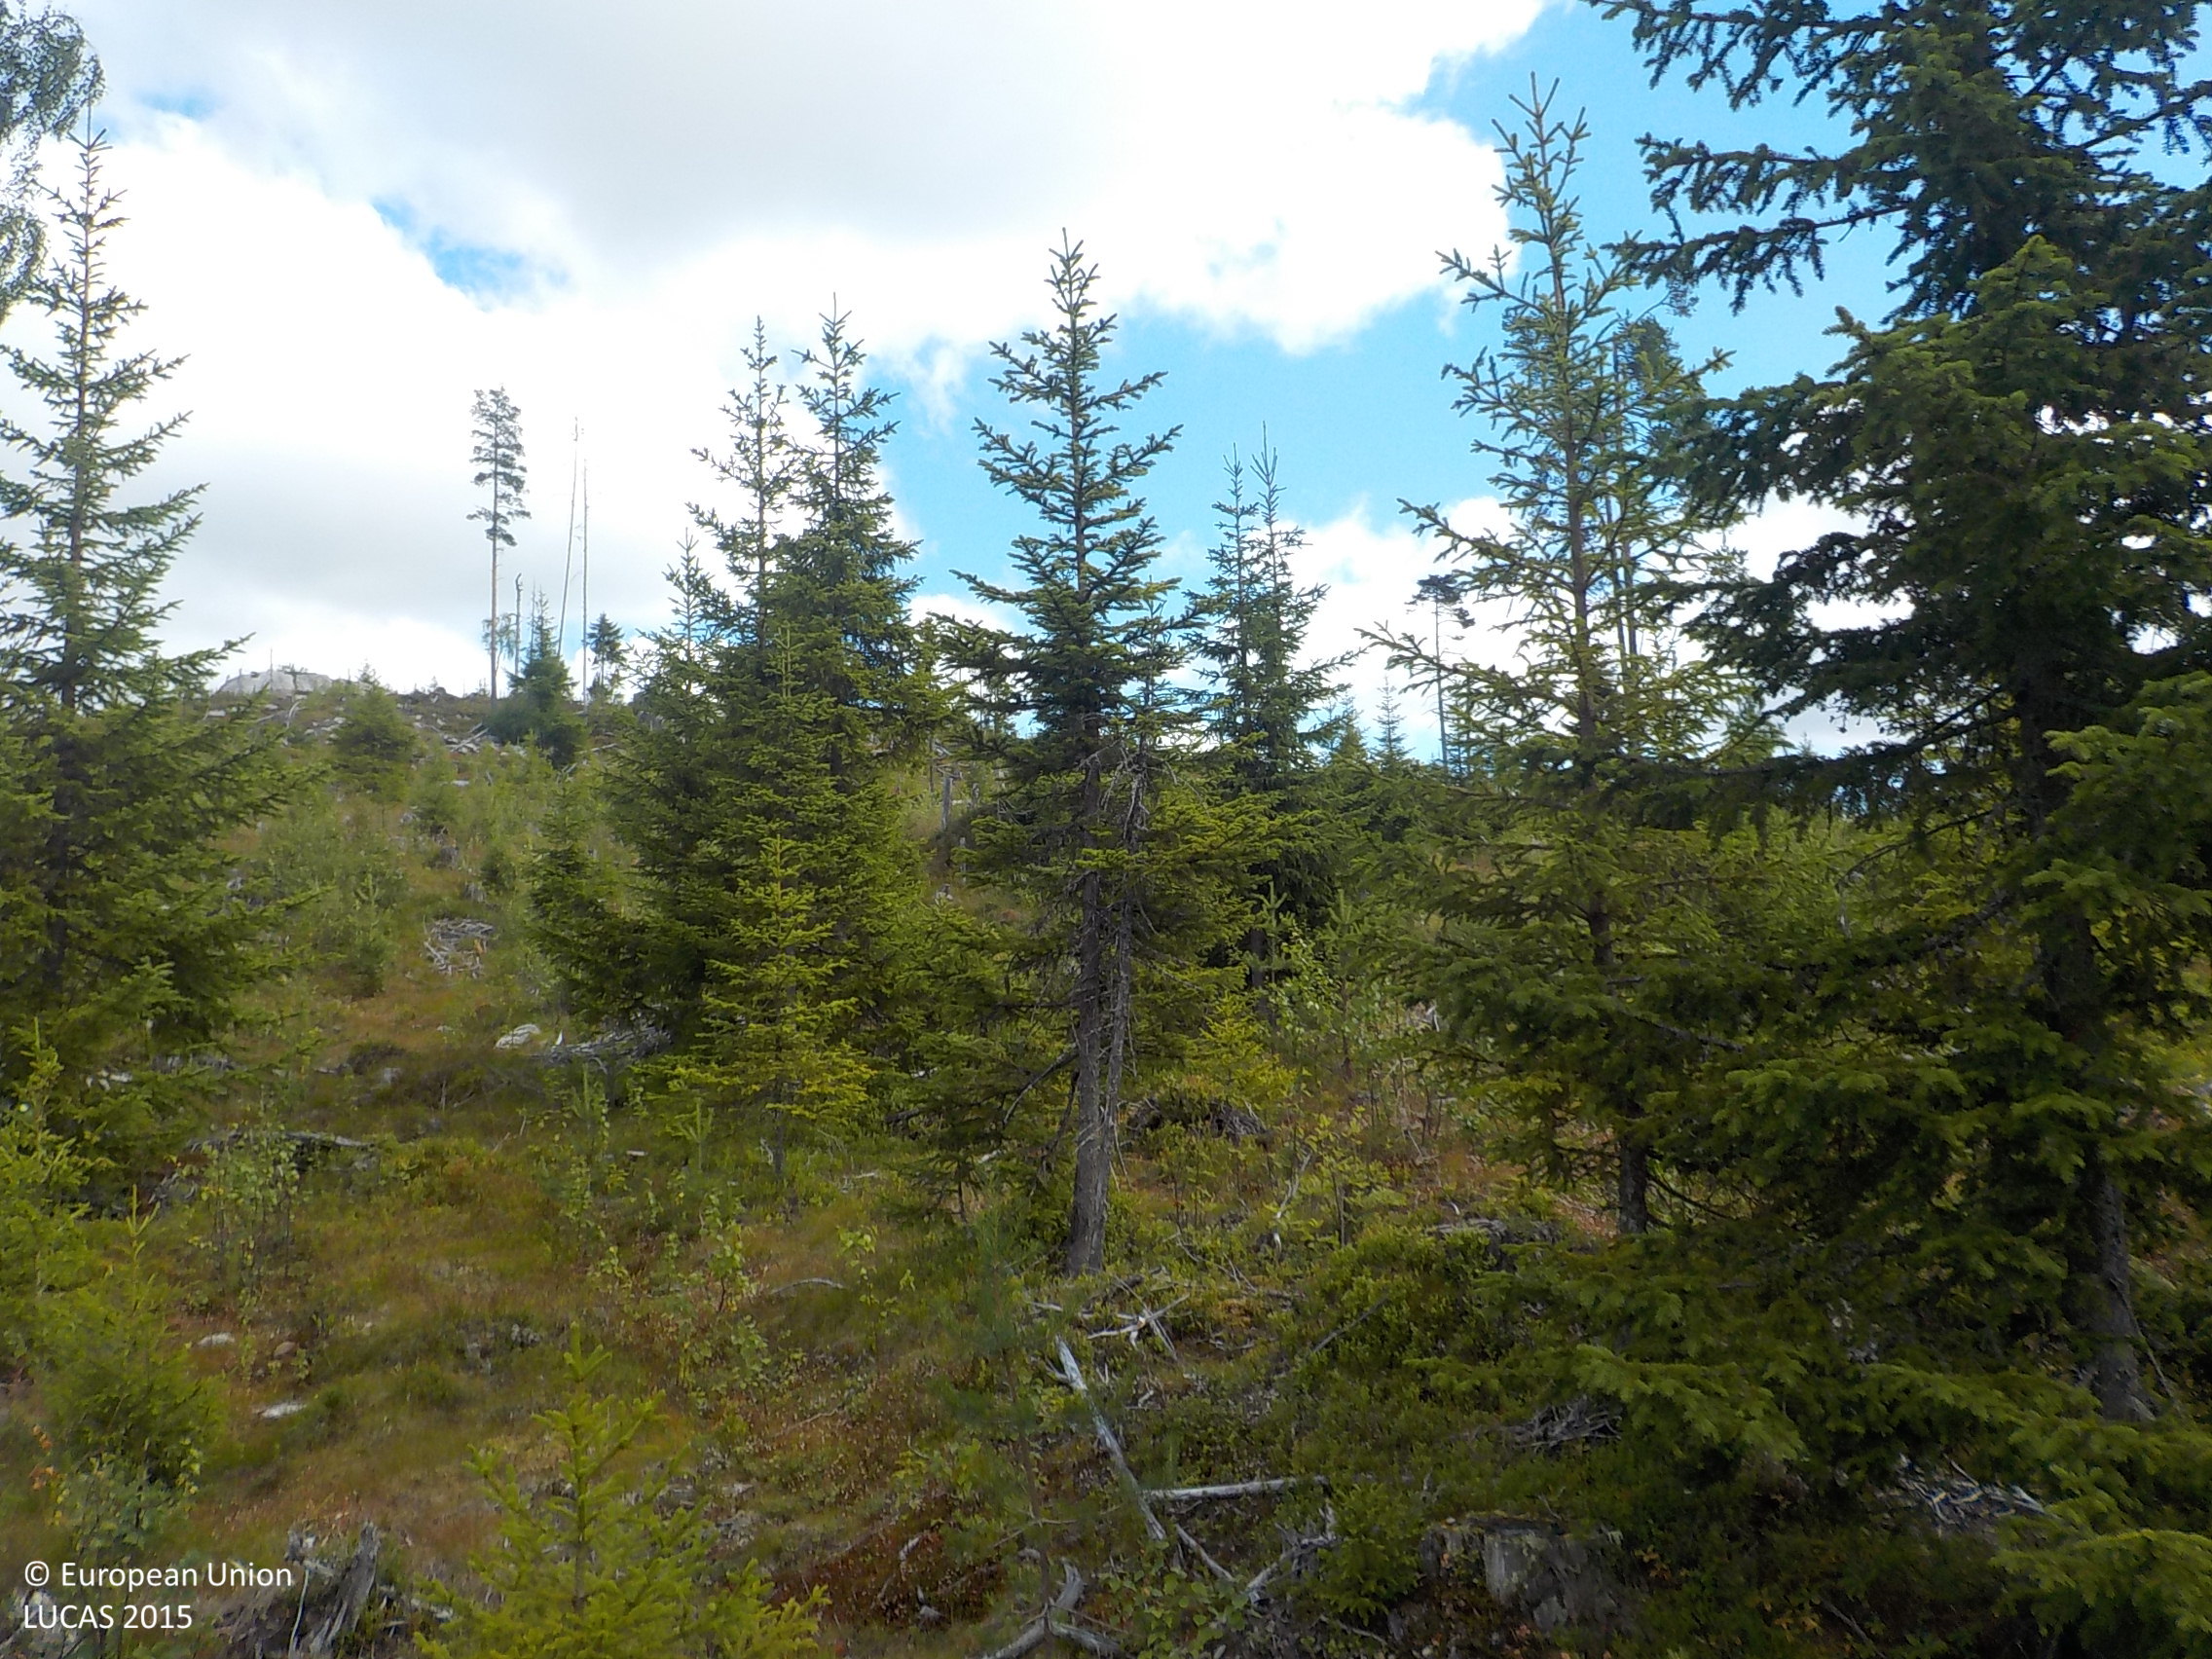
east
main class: Woodland
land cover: Spruce dominated mixed woodland
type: boreal forest
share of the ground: 25 - 50 %
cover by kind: herbaceous plants 60 %, coniferous forest trees 20 %, broadleaved forest trees 10 %, shrubs 5 %, lichens and mosses 5 %
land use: Forestry
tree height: < 5 m
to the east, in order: Spruce dominated mixed woodland
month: August
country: SE
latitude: 64.1238
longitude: 17.6301
